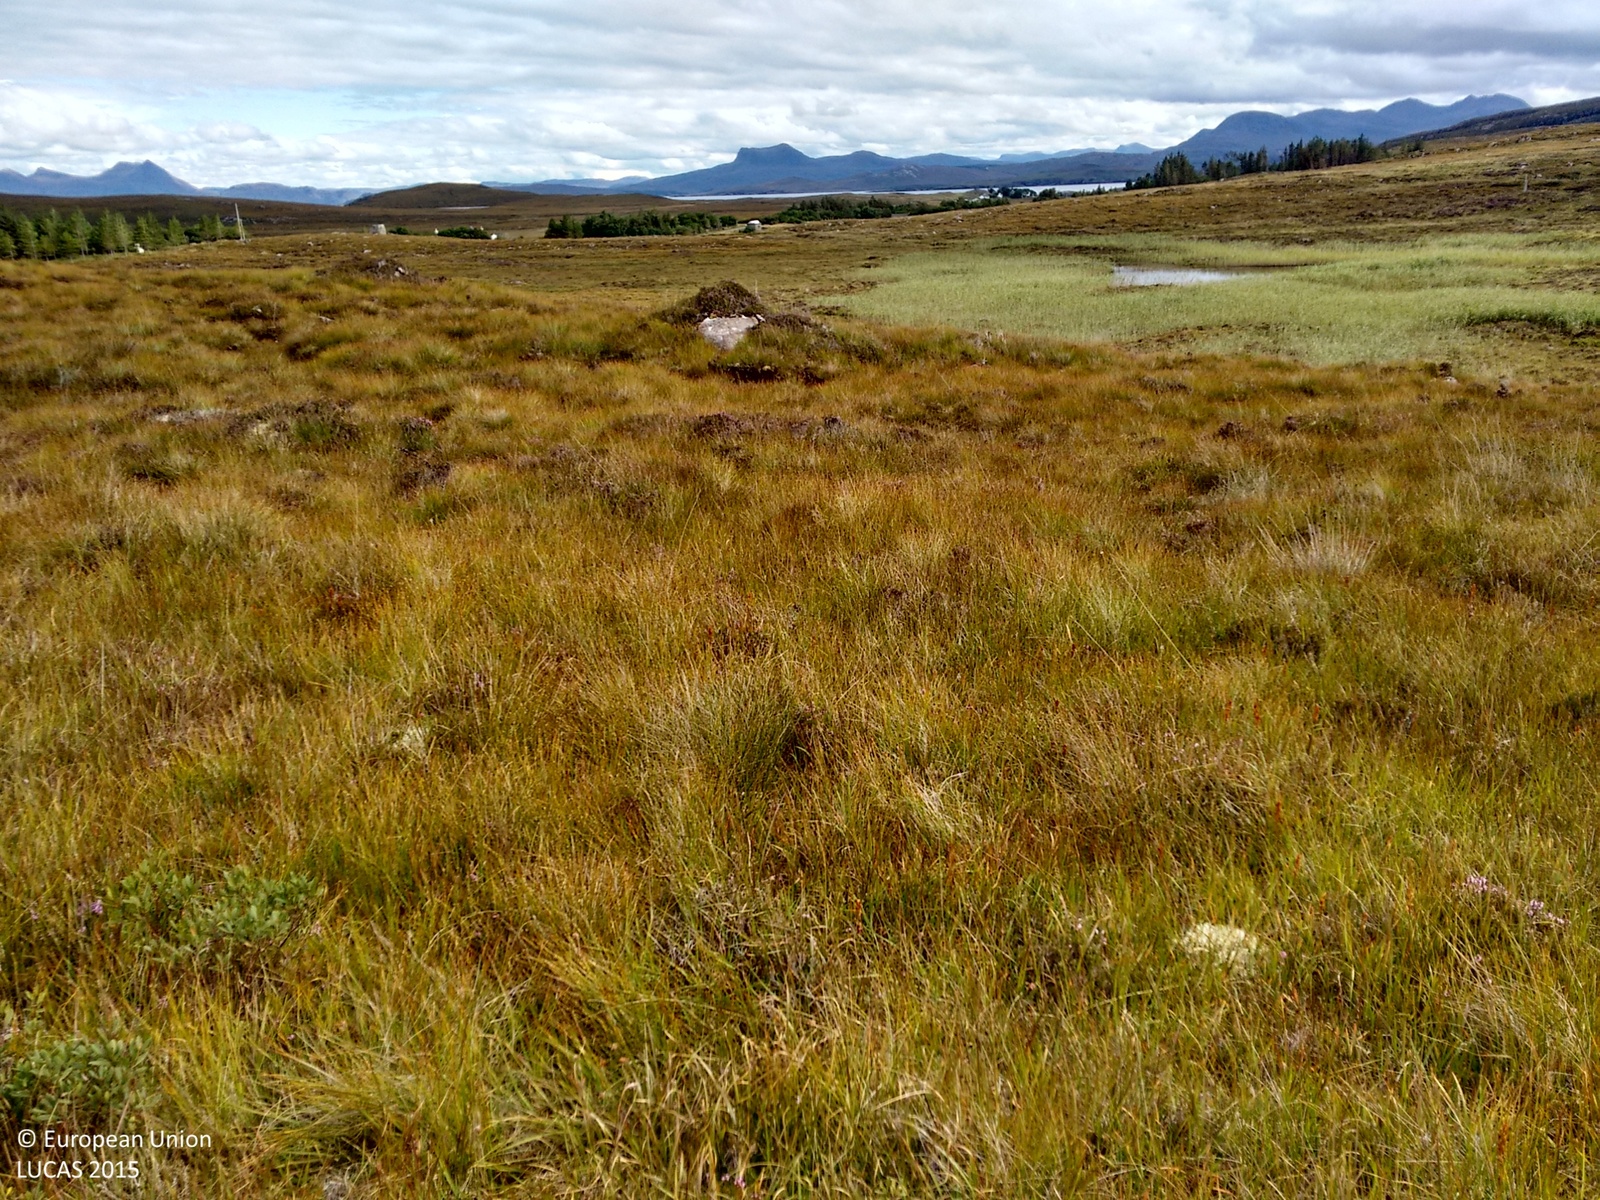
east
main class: Shrubland
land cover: Shrubland without tree cover
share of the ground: 25 - 50 %
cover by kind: shrubs 50 %, herbaceous plants 50 %
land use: Semi-natural and natural areas not in use
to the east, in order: Shrubland without tree cover; Peatbogs; Shrubland without tree cover
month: September
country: GB
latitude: 57.9077
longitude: -5.5901
